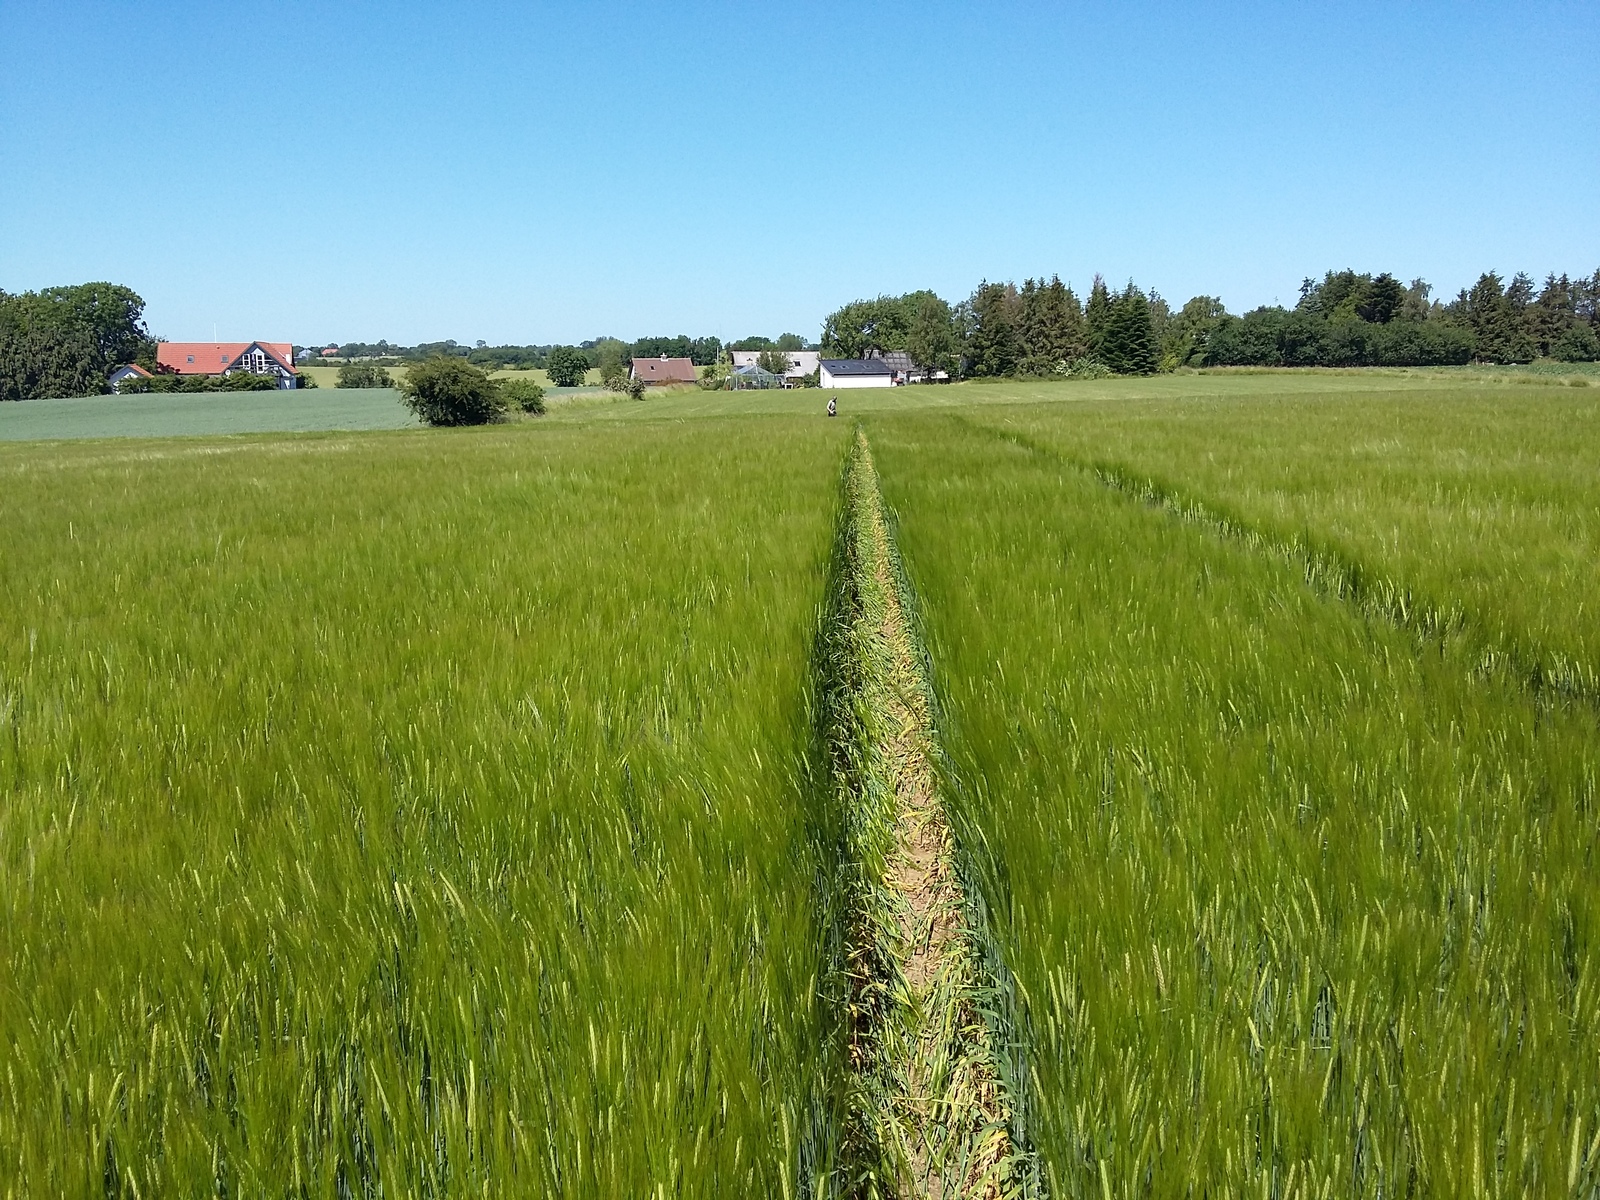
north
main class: Cropland
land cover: Barley
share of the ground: > 75 %
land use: Agriculture (excluding fallow land and kitchen gardens)
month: July
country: DK
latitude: 54.8928
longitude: 12.1659
